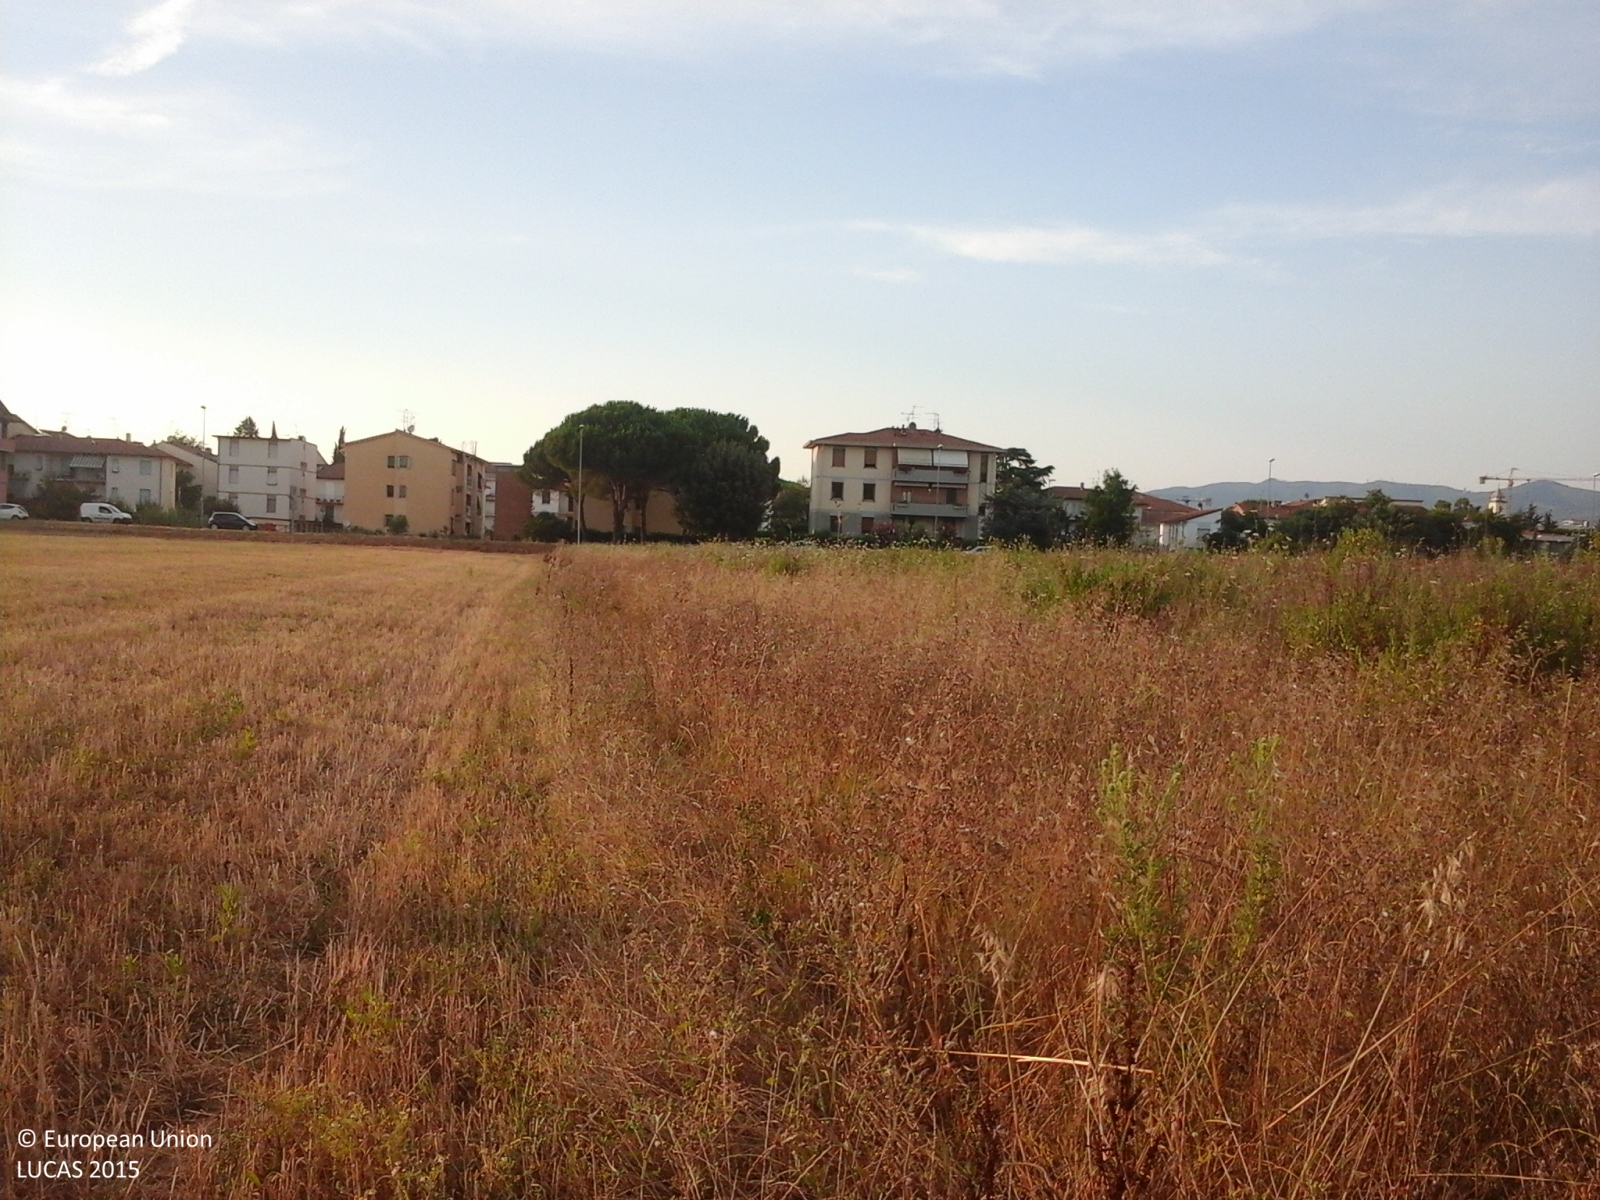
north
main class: Grassland
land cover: Grassland without tree/shrub cover
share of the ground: > 75 %
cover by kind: herbaceous plants 100 %
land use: Agriculture (excluding fallow land and kitchen gardens)
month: July
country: IT
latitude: 43.7149
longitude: 10.9284
